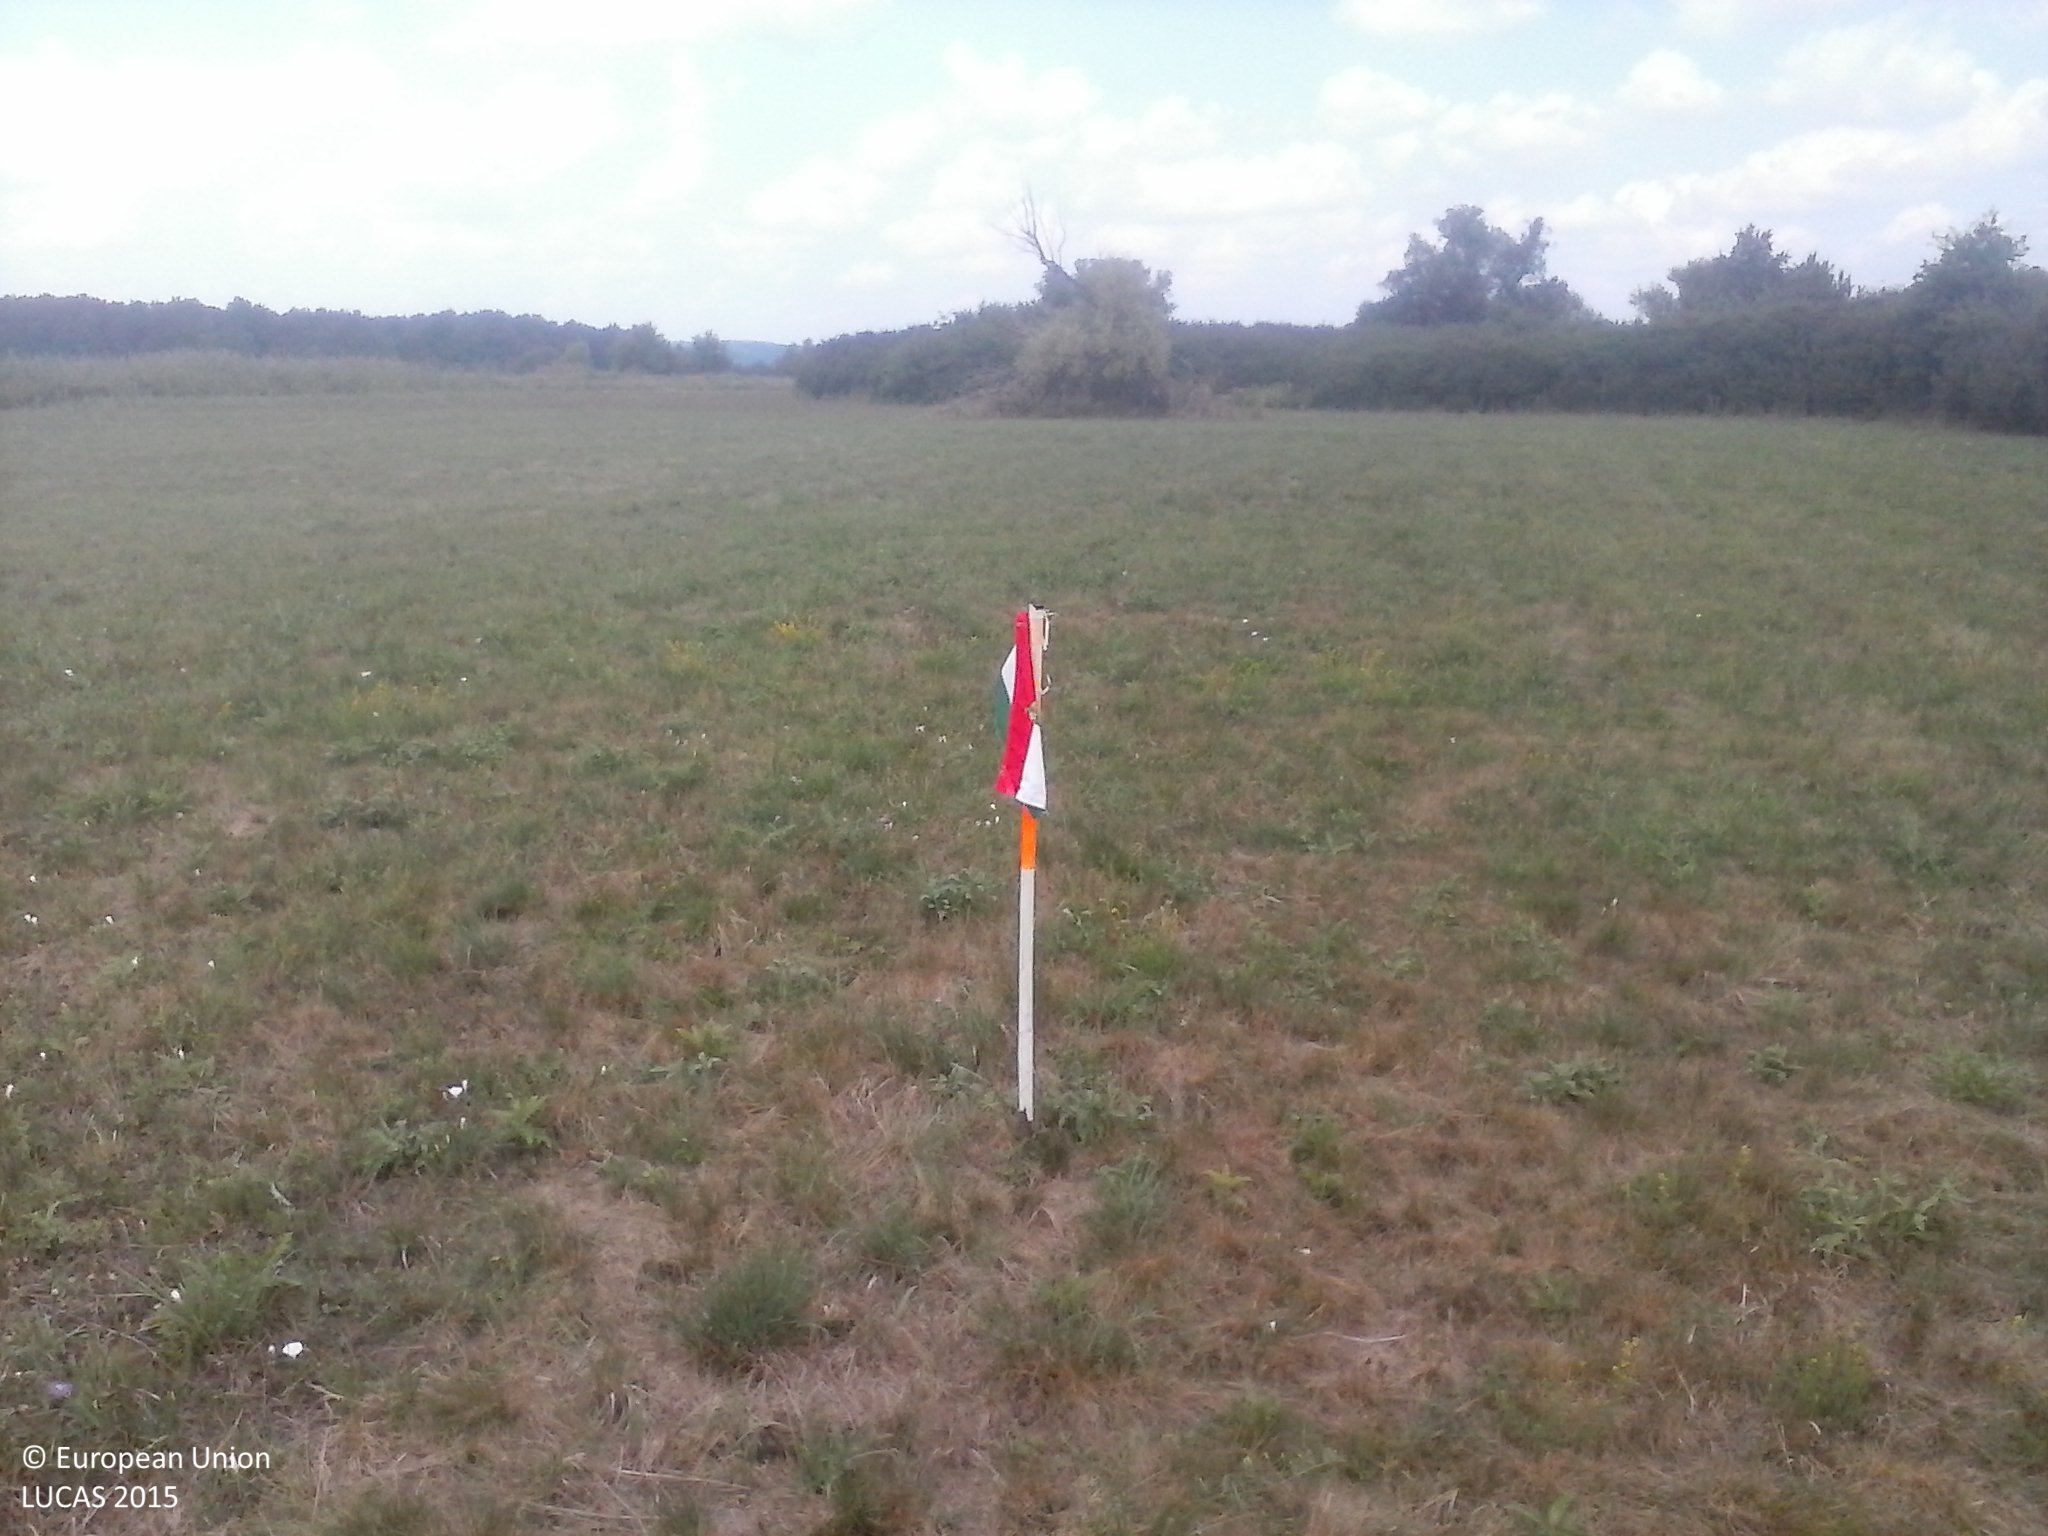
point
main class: Grassland
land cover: Grassland without tree/shrub cover
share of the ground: > 75 %
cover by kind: herbaceous plants 100 %
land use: Agriculture (excluding fallow land and kitchen gardens)
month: August
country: HU
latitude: 46.0527
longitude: 17.9803
